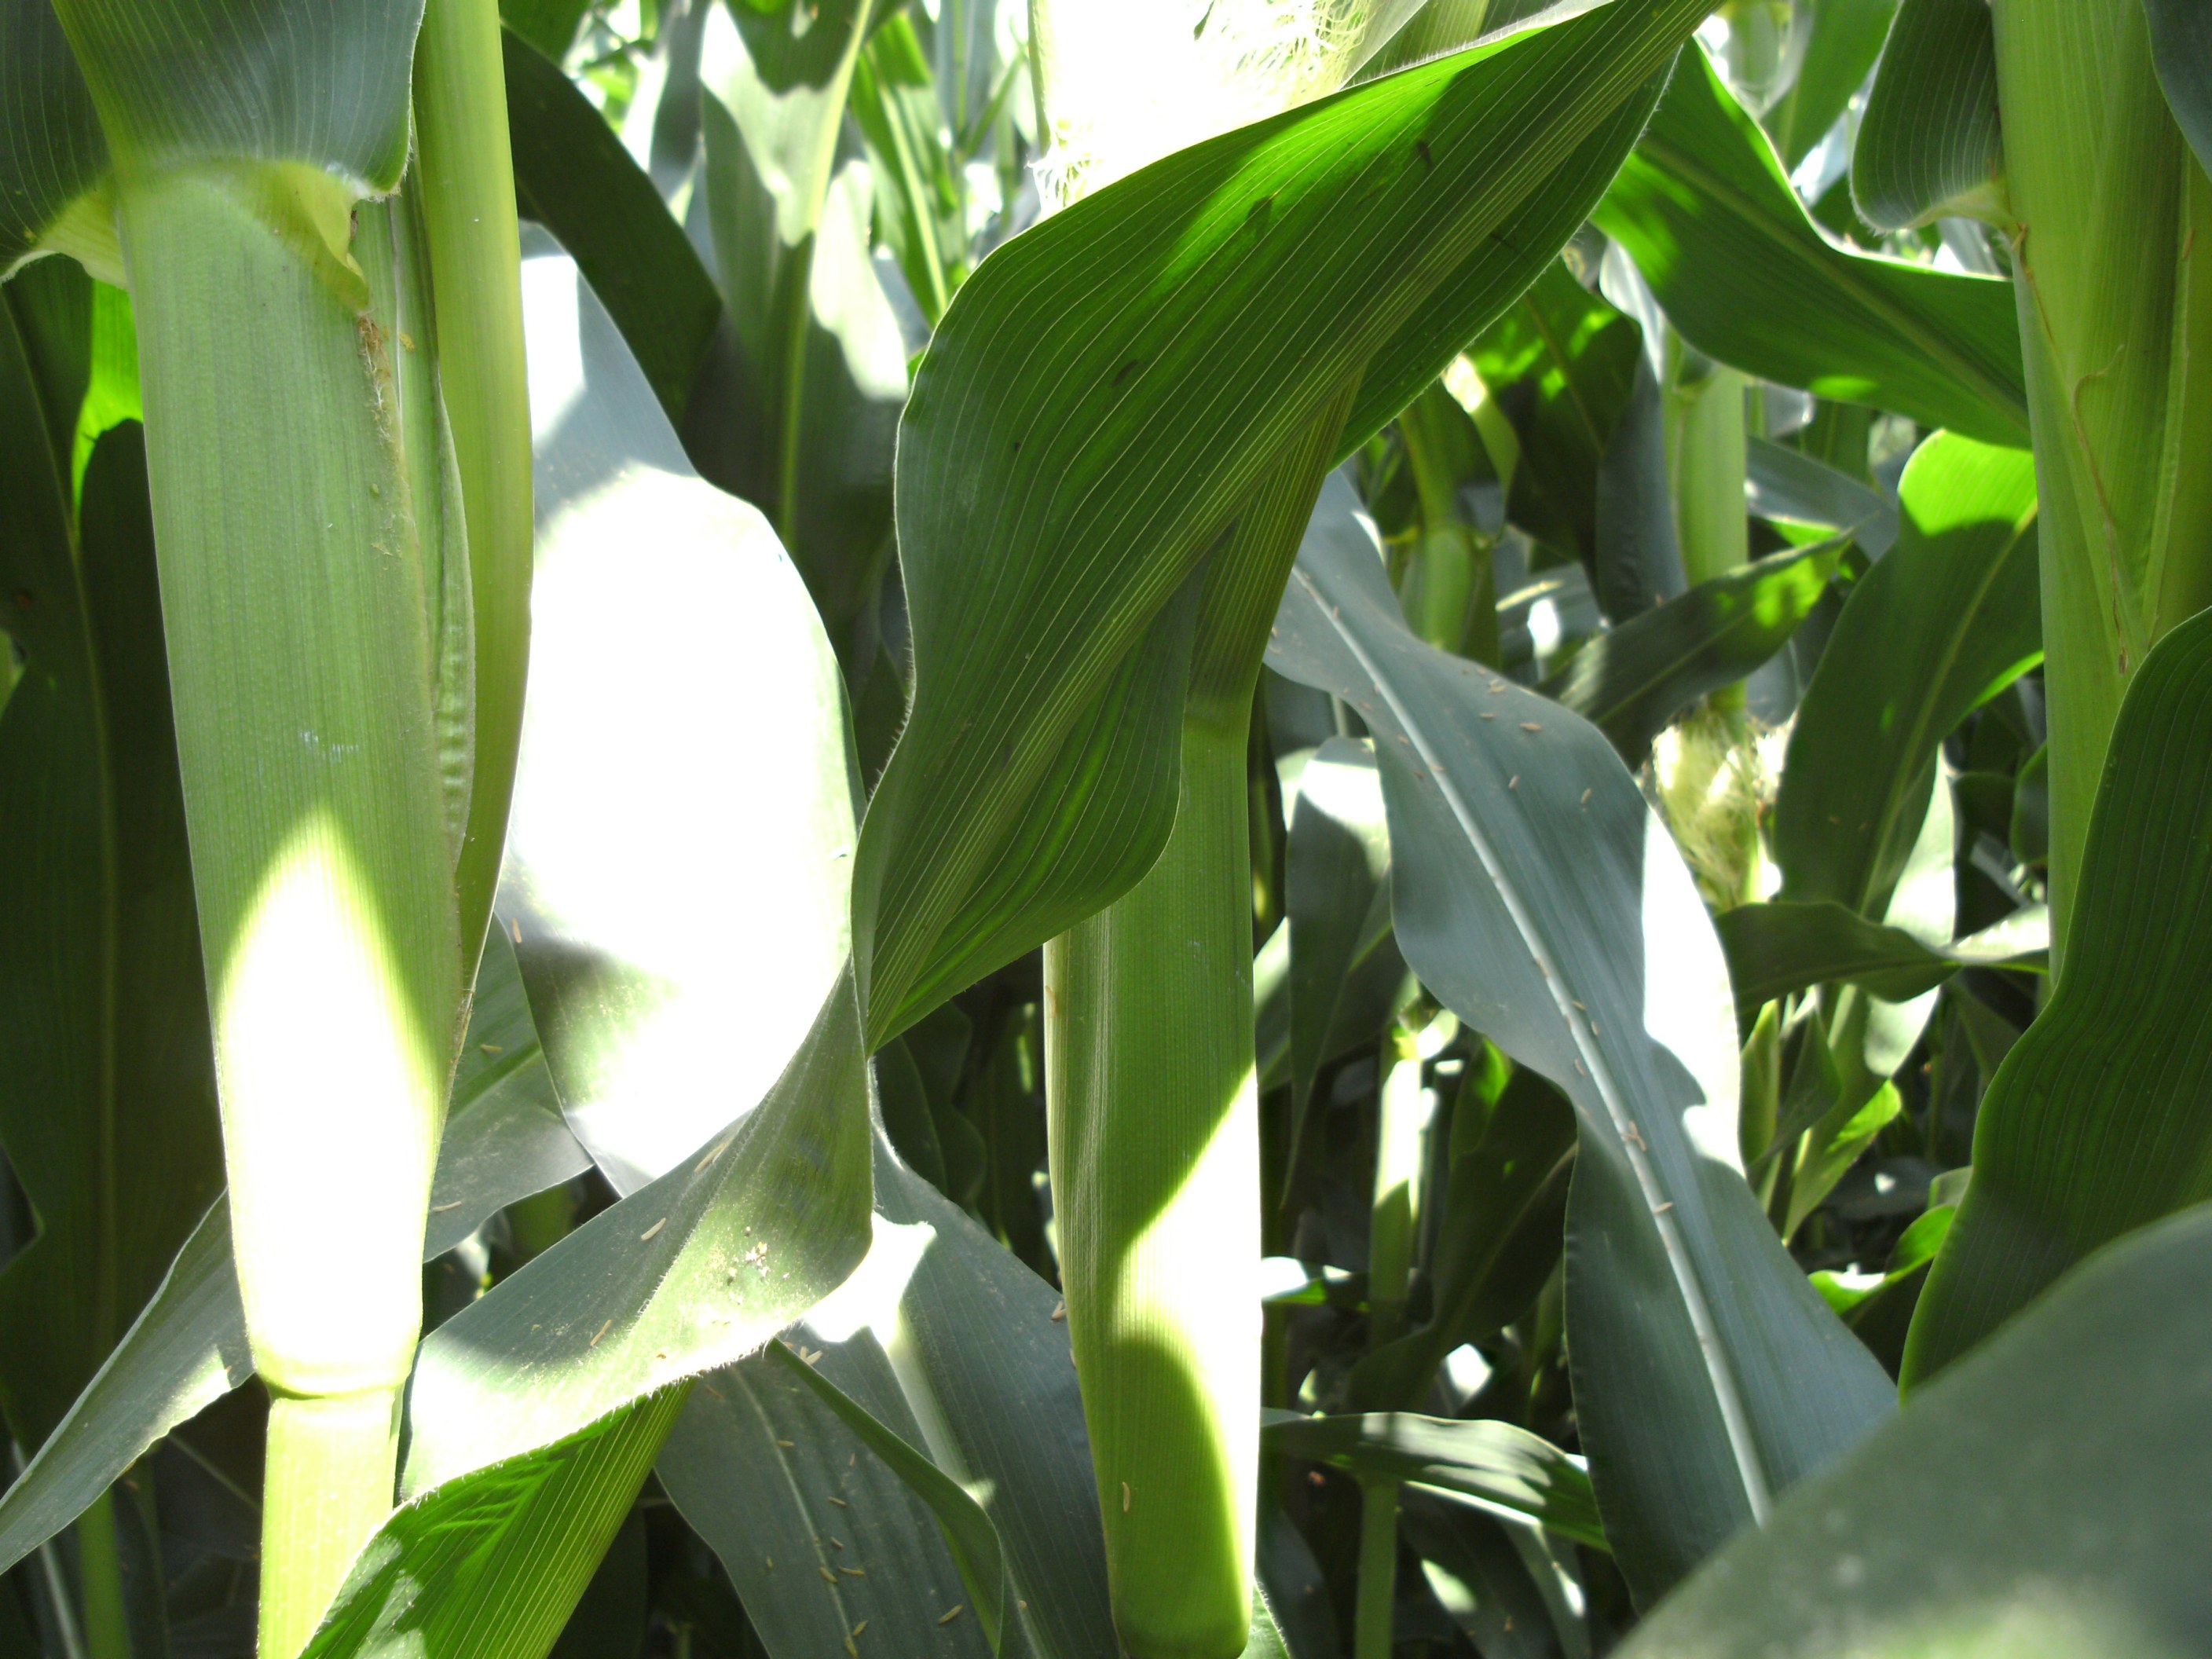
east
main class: Cropland
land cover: Maize
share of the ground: > 75 %
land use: Agriculture (excluding fallow land and kitchen gardens)
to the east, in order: Maize; Shrubland without tree cover; Spruce dominated mixed woodland; Tracks; Spruce dominated mixed woodland; Broadleaved woodland; Tracks; Spruce dominated mixed woodland; Tracks; Spruce dominated mixed woodland; Spruce dominated coniferous woodland; Tracks; Spruce dominated coniferous woodland; Tracks; Spruce dominated mixed woodland; Tracks; Spruce dominated coniferous woodland
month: July
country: AT
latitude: 46.7833
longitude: 14.8316
